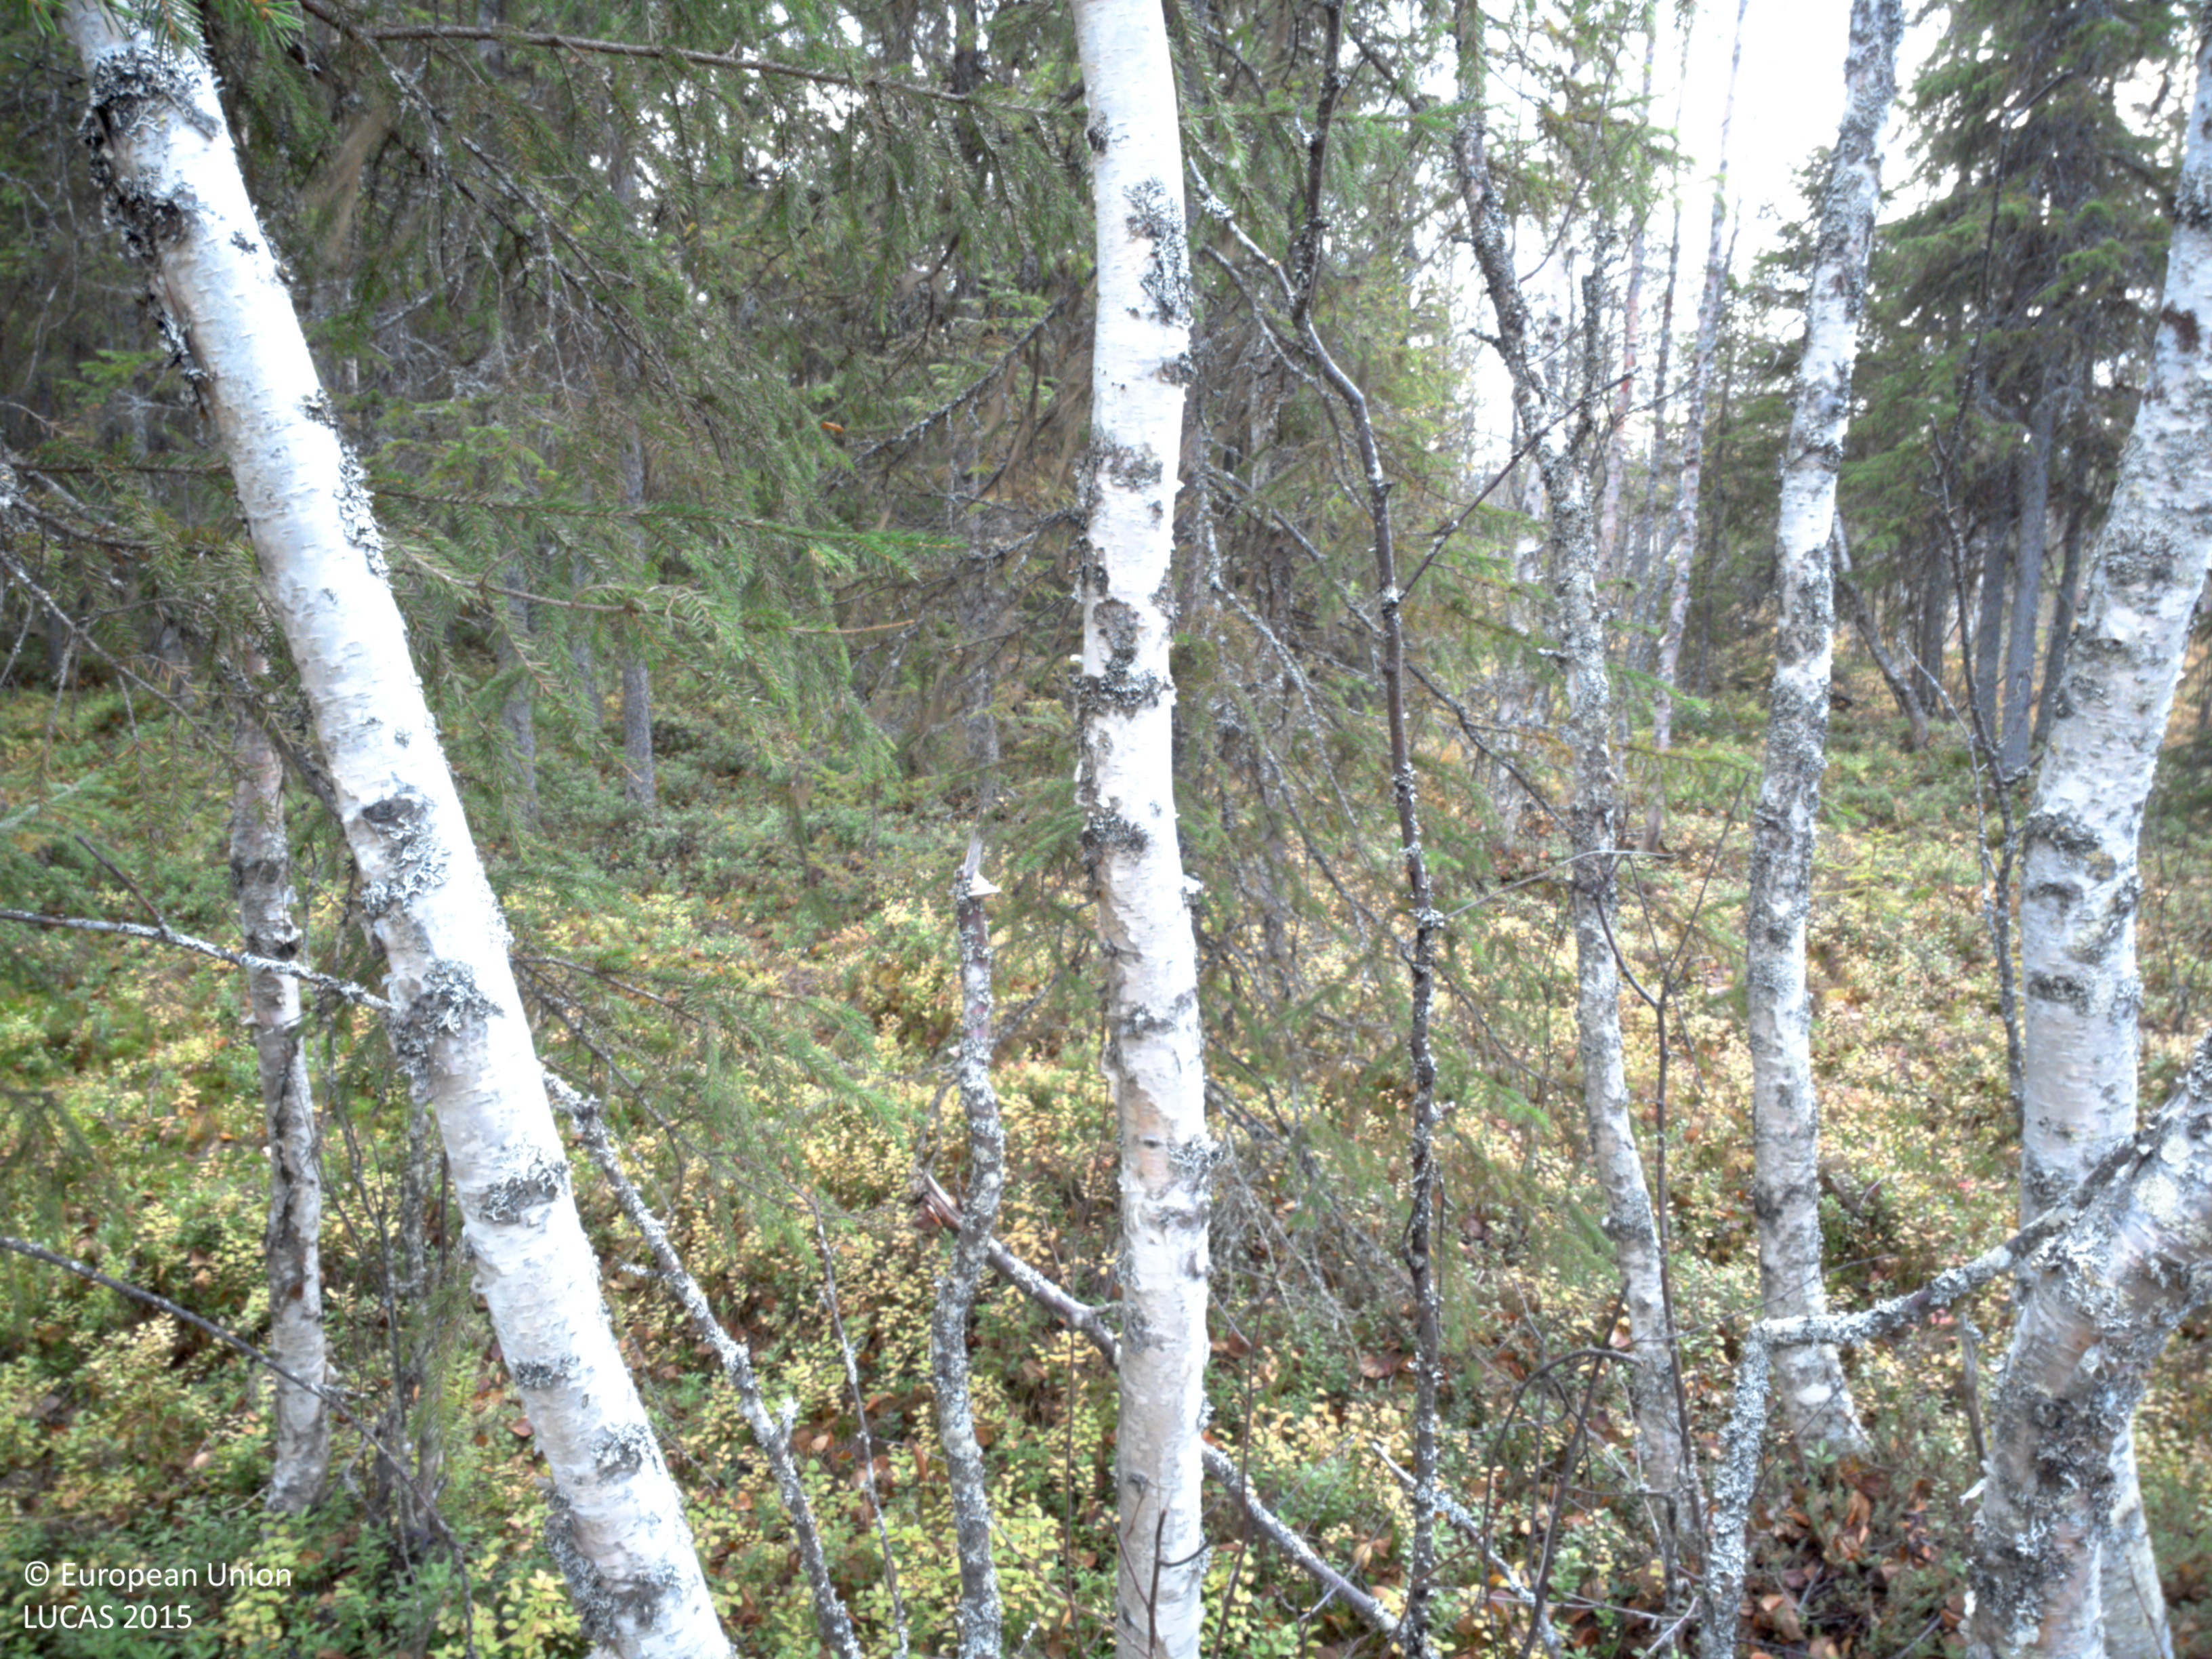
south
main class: Woodland
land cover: Spruce dominated mixed woodland
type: boreal forest
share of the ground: 50 - 75 %
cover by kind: coniferous forest trees 30 %, broadleaved forest trees 30 %, shrubs 30 %, lichens and mosses 10 %
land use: Forestry
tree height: > 5 m
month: October
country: SE
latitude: 64.7924
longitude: 18.0671
